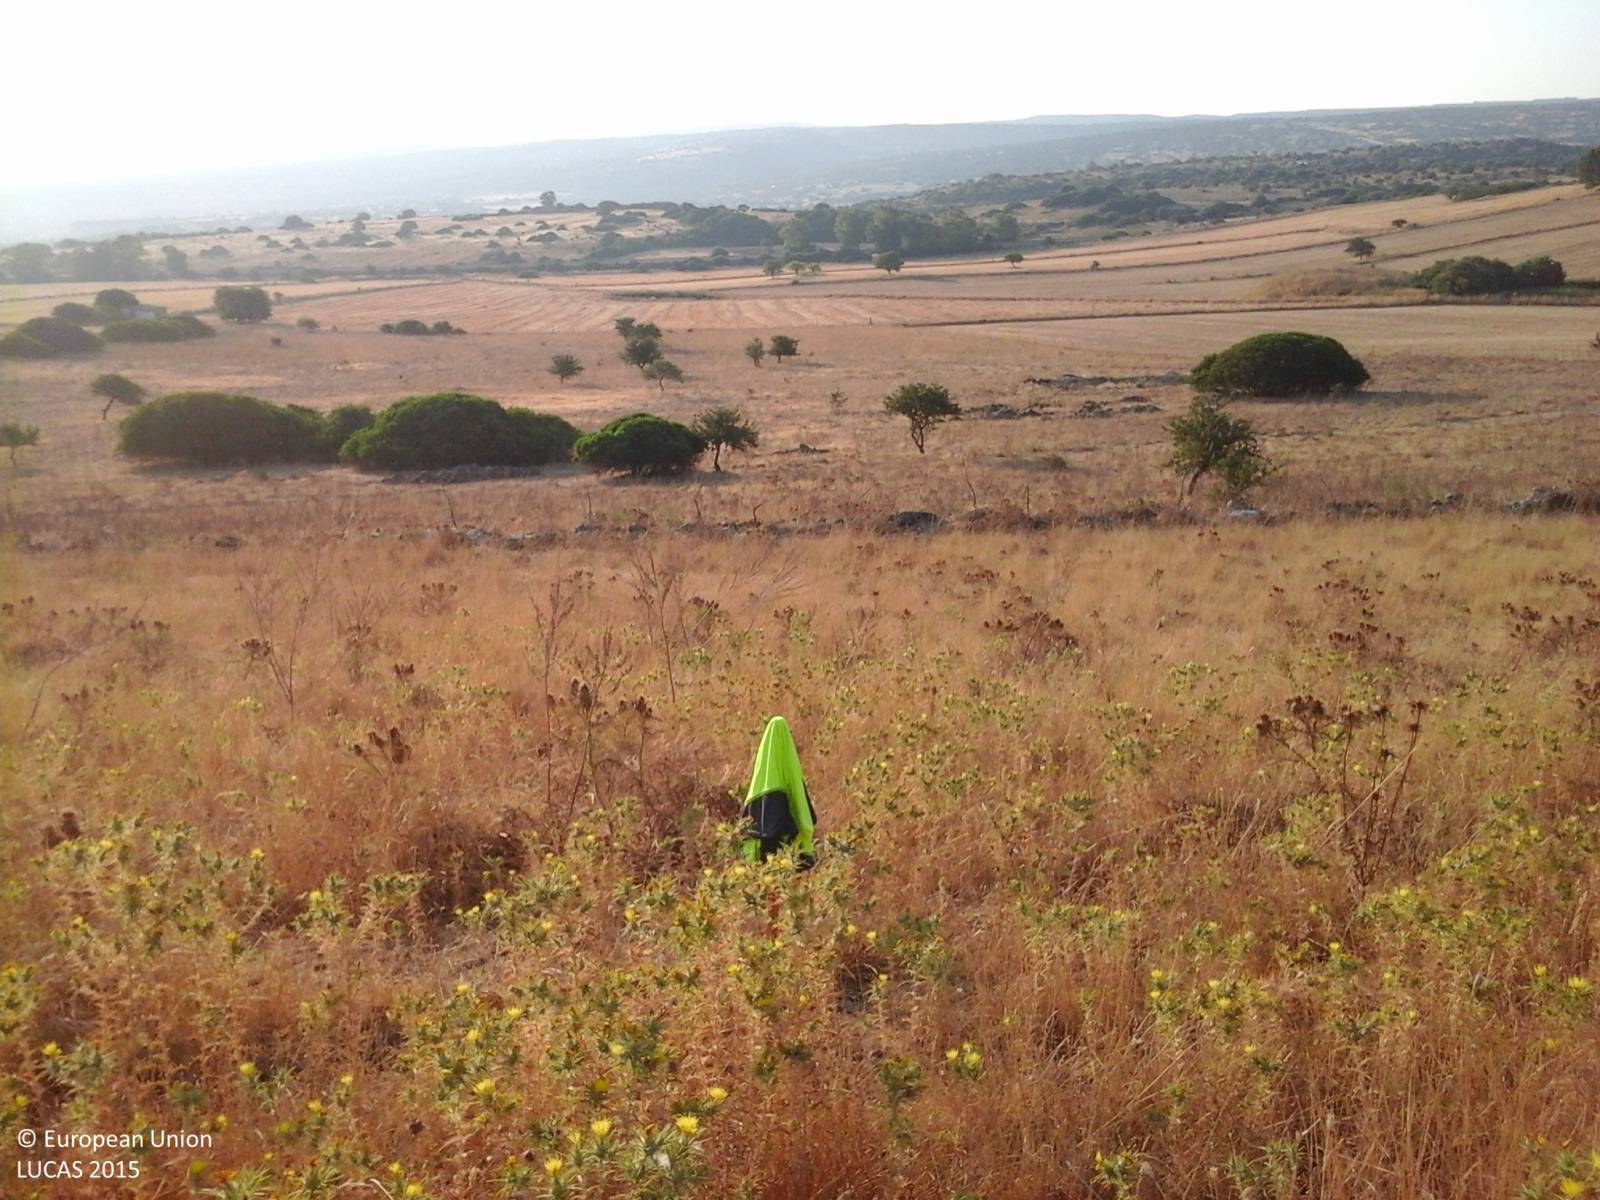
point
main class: Grassland
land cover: Spontaneously vegetated surfaces
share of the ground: > 75 %
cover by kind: herbaceous plants 100 %
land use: Agriculture (excluding fallow land and kitchen gardens)
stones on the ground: < 10 %
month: July
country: IT
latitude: 40.7855
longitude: 8.8560
